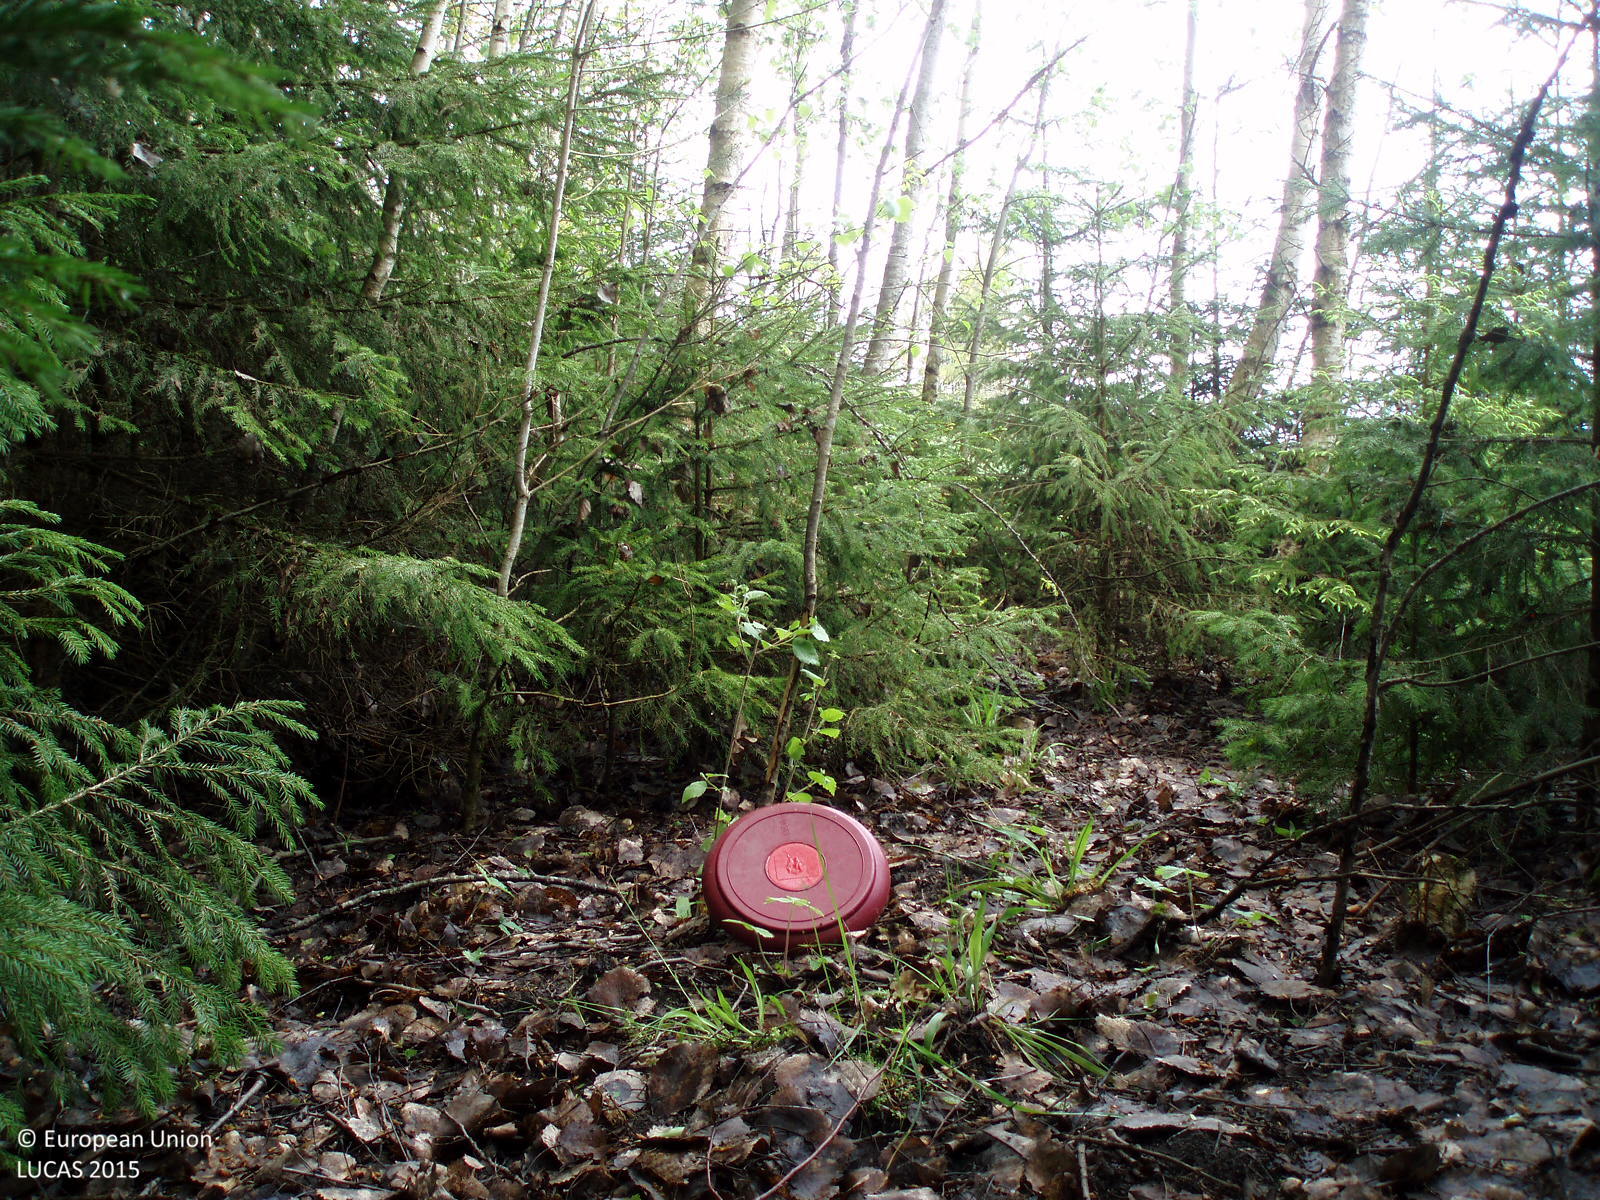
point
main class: Woodland
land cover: Spruce dominated mixed woodland
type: hemiboreal forest and nemoral coniferous forest and mixed broadleaved-coniferous forest
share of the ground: > 75 %
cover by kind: broadleaved forest trees 60 %, coniferous forest trees 40 %
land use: Forestry
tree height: > 5 m
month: May
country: LT
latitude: 56.2766
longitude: 22.5760
